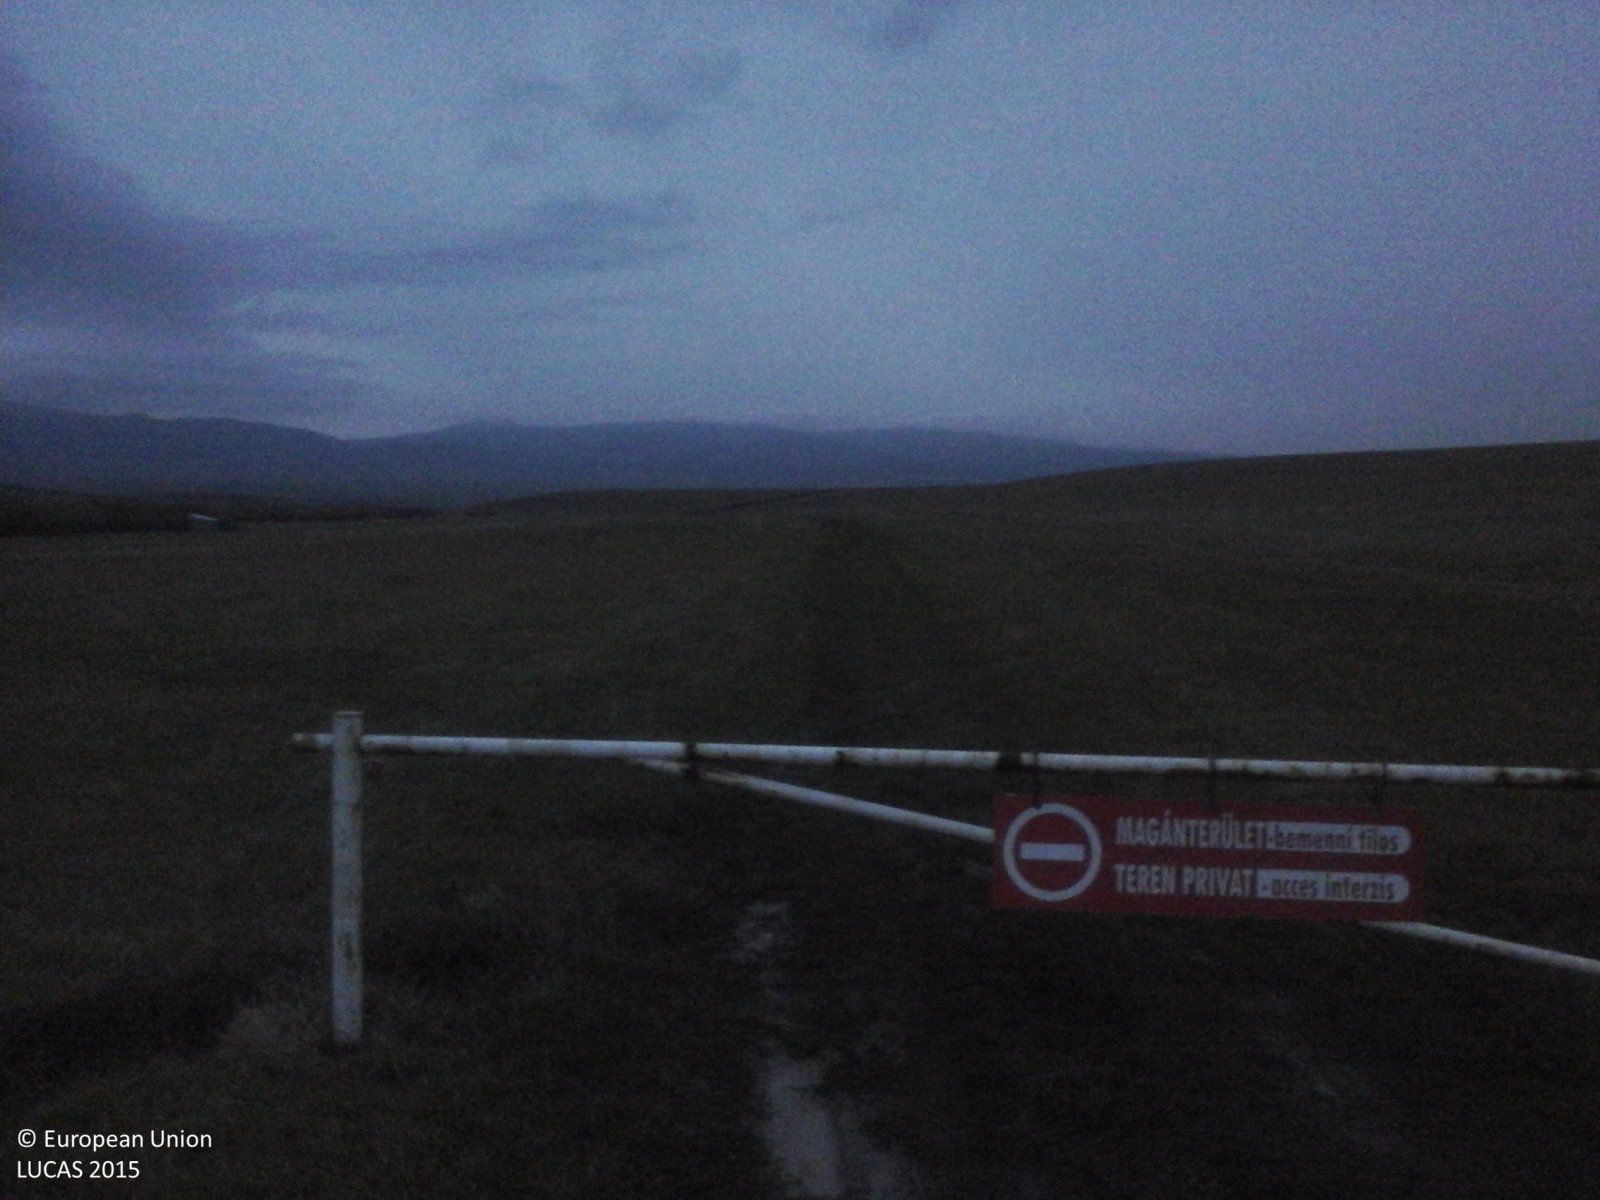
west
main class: Grassland
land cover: Grassland without tree/shrub cover
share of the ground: > 75 %
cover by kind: herbaceous plants 100 %
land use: Agriculture (excluding fallow land and kitchen gardens)
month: October
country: RO
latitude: 46.8271
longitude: 25.4878
